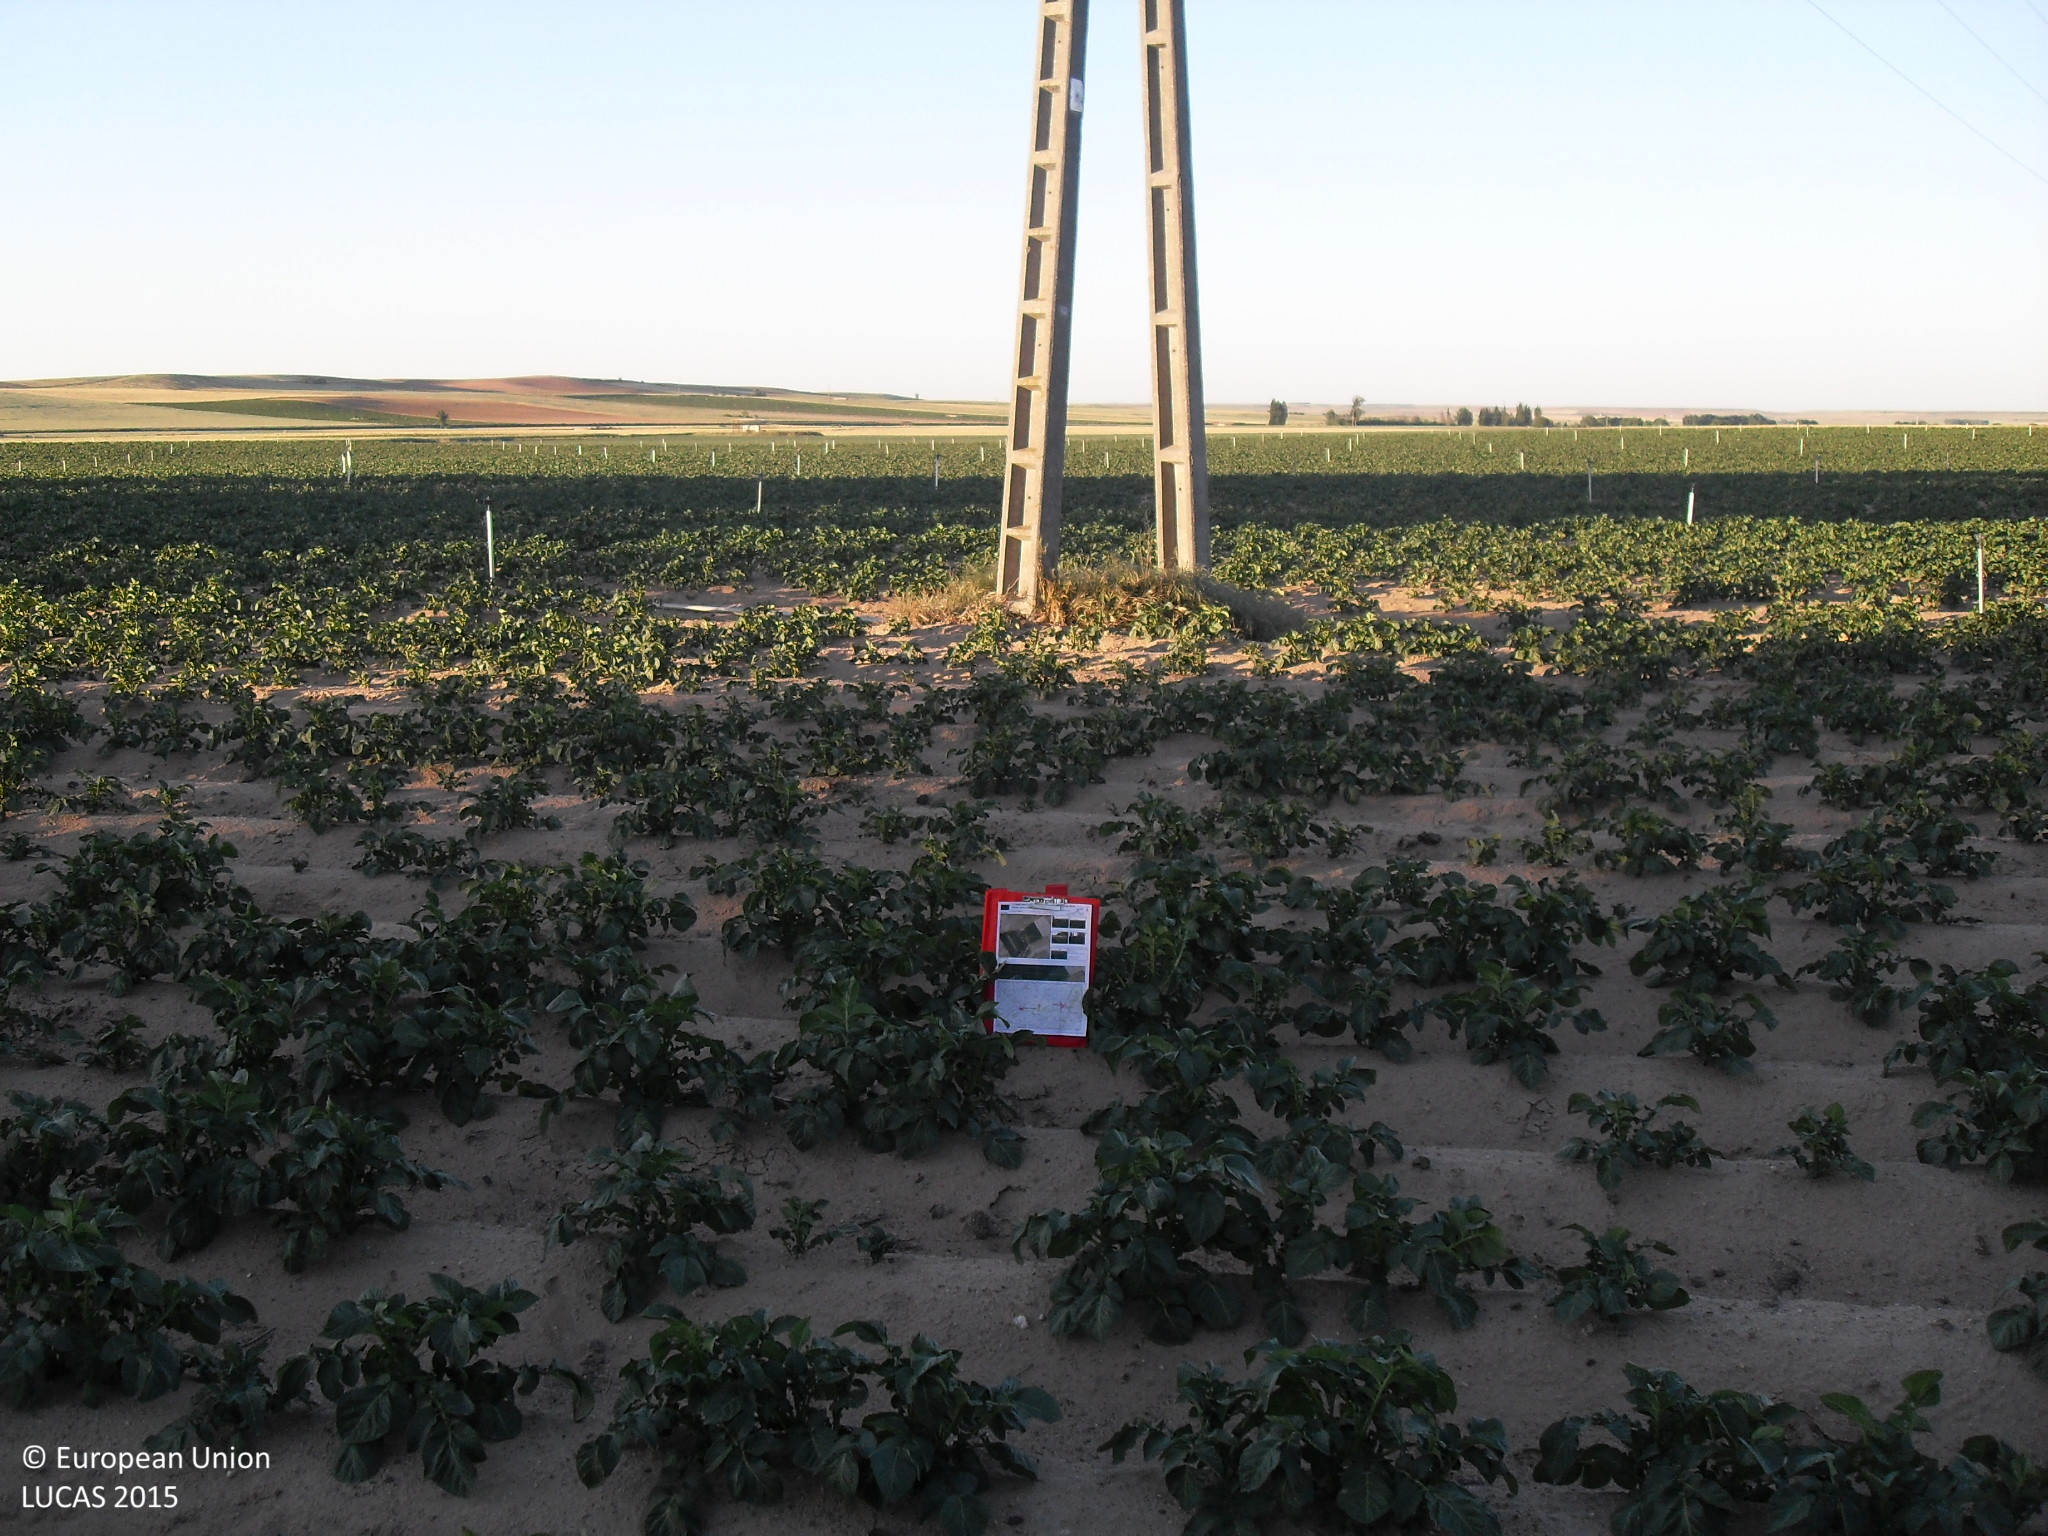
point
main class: Cropland
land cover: Potatoes
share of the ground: 25 - 50 %
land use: Agriculture (excluding fallow land and kitchen gardens)
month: May
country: ES
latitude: 41.0519
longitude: -5.3614
